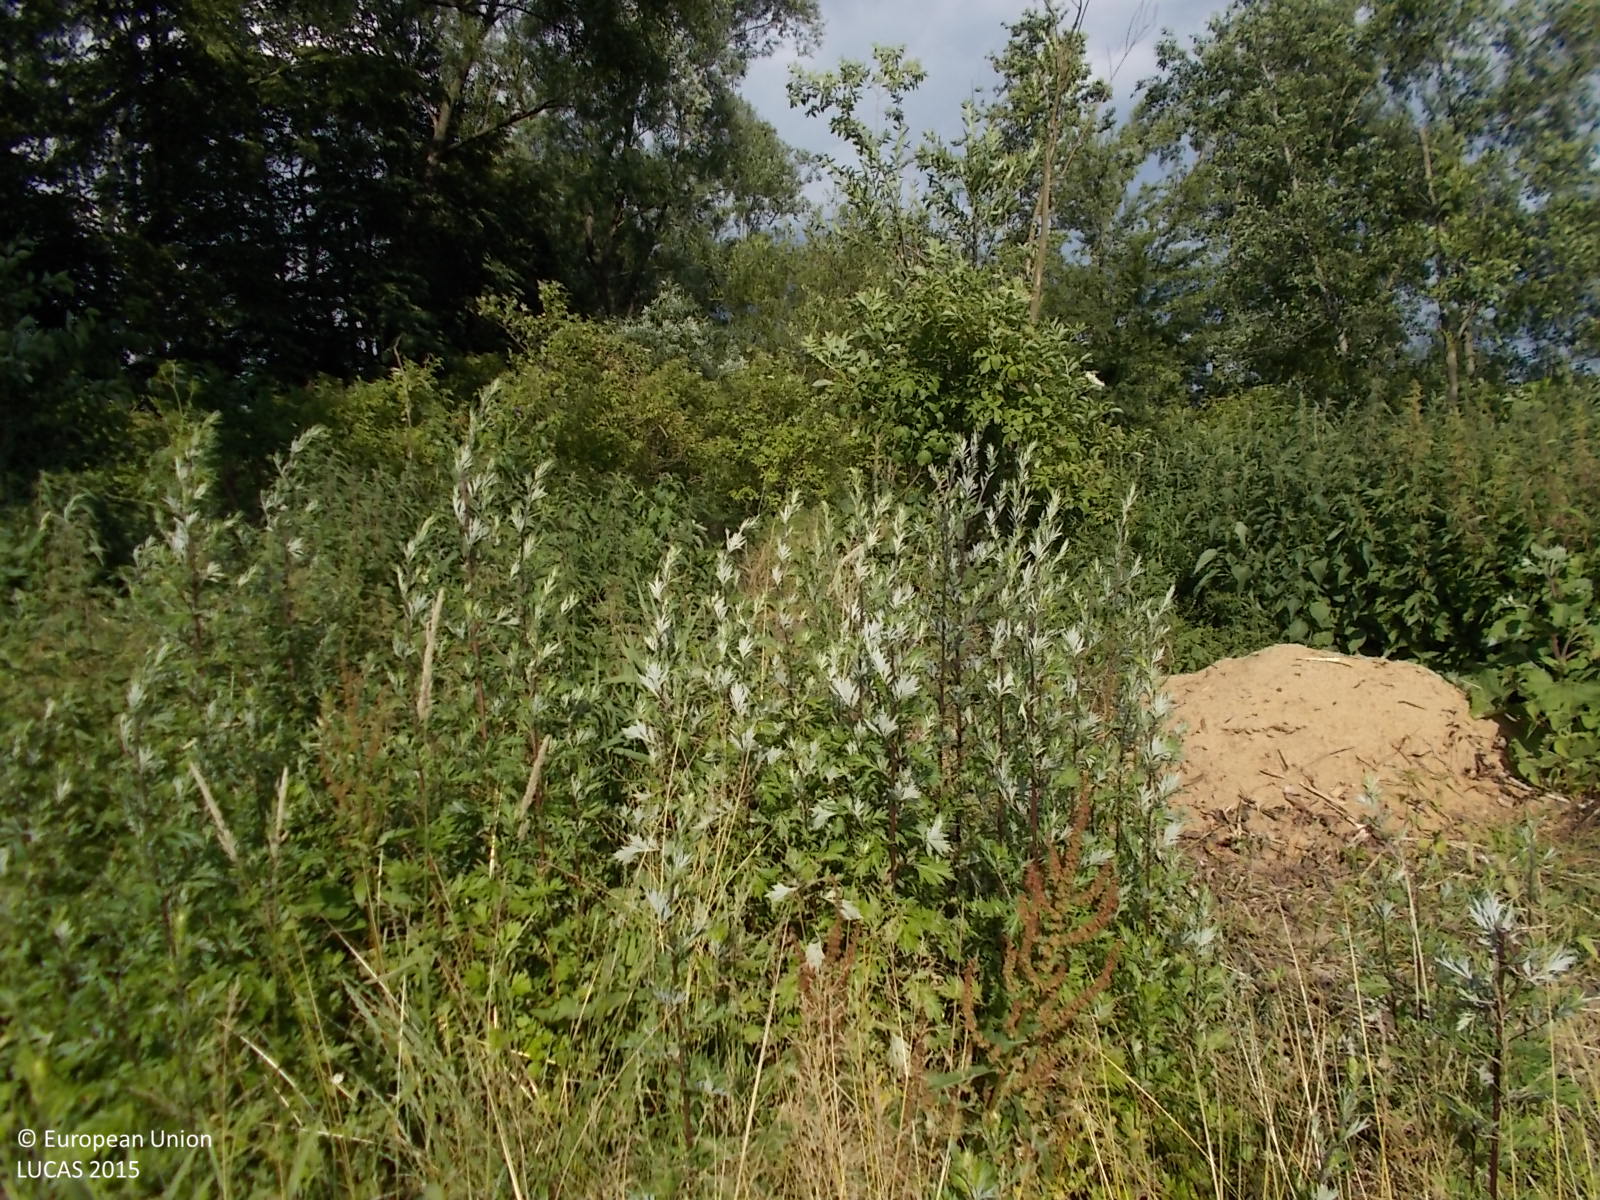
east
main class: Woodland
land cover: Broadleaved woodland
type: mesophytic deciduous forest
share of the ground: 25 - 50 %
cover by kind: broadleaved forest trees 45 %, shrubs 30 %, herbaceous plants 15 %, unconsolidated bare surface 10 %
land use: Semi-natural and natural areas not in use
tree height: > 5 m
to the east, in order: Broadleaved woodland; Spontaneously vegetated surfaces; Common wheat
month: June
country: CZ
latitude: 49.4240
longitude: 17.6090
